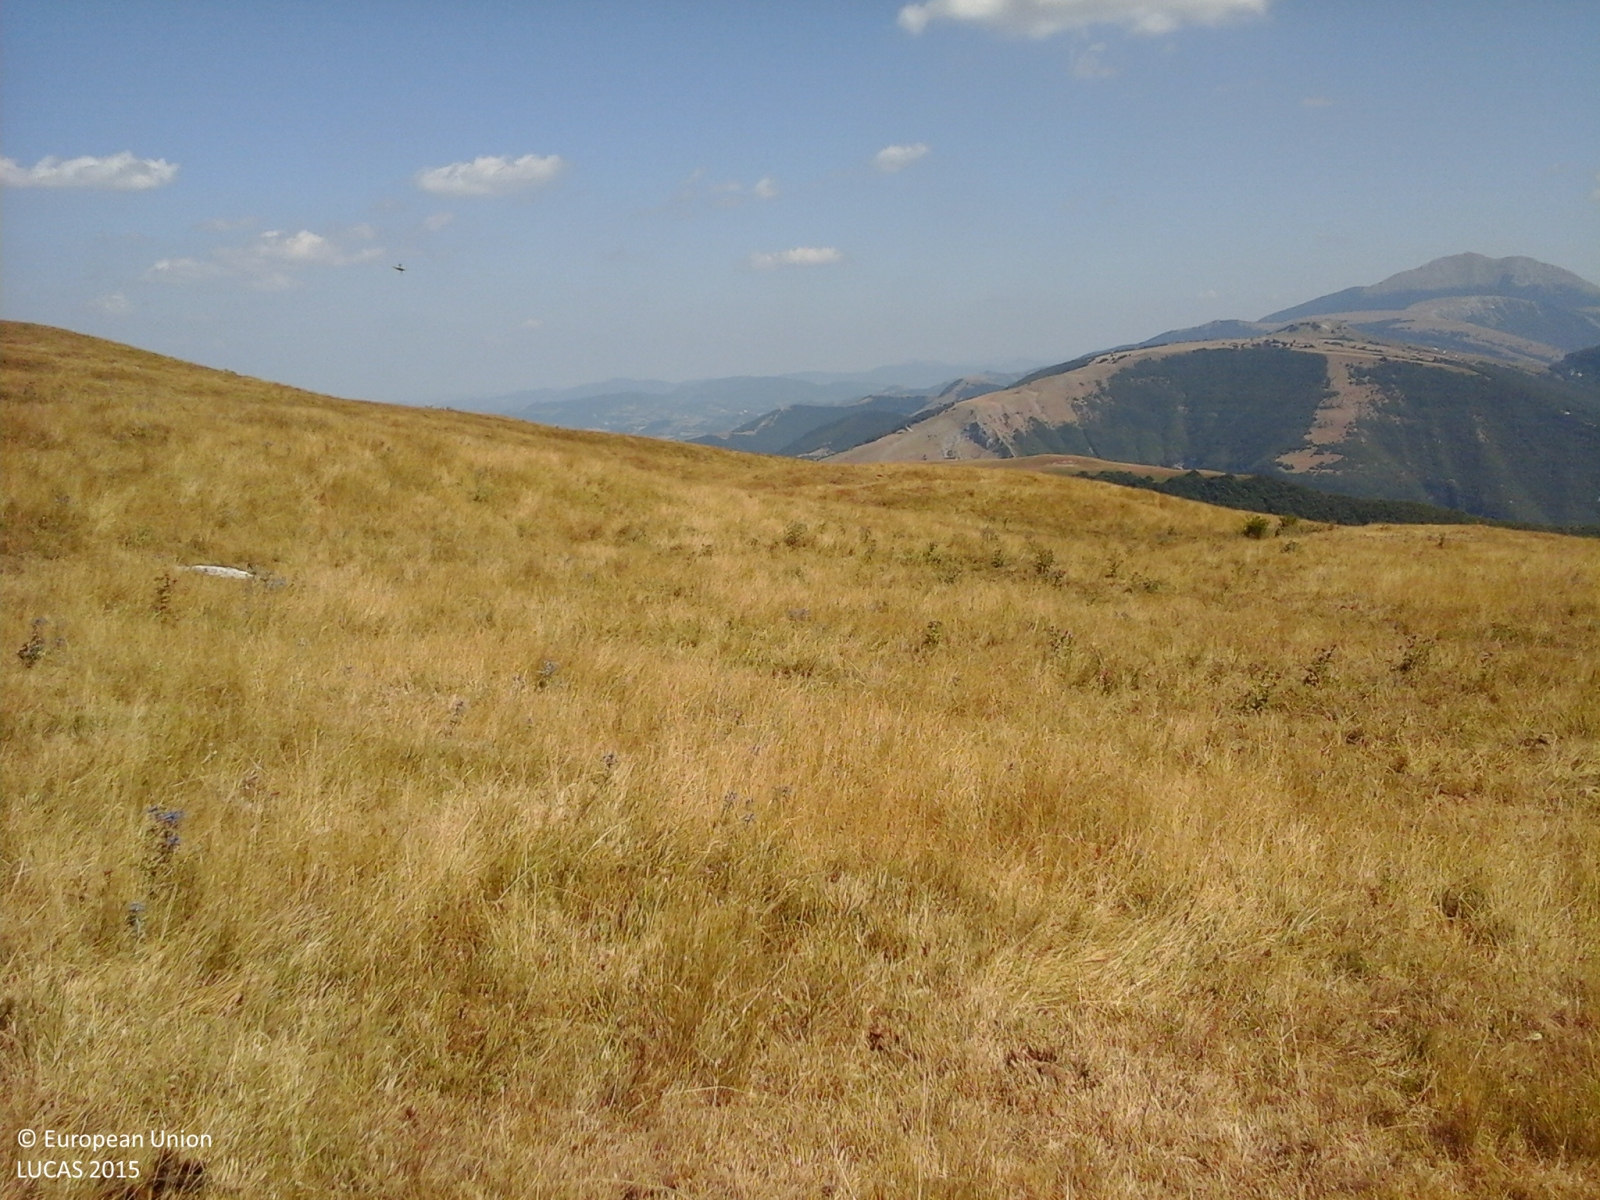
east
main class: Grassland
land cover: Grassland without tree/shrub cover
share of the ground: > 75 %
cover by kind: herbaceous plants 100 %
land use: Agriculture (excluding fallow land and kitchen gardens)
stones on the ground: < 10 %
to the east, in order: Grassland without tree/shrub cover
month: August
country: IT
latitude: 43.5430
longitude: 12.5553
